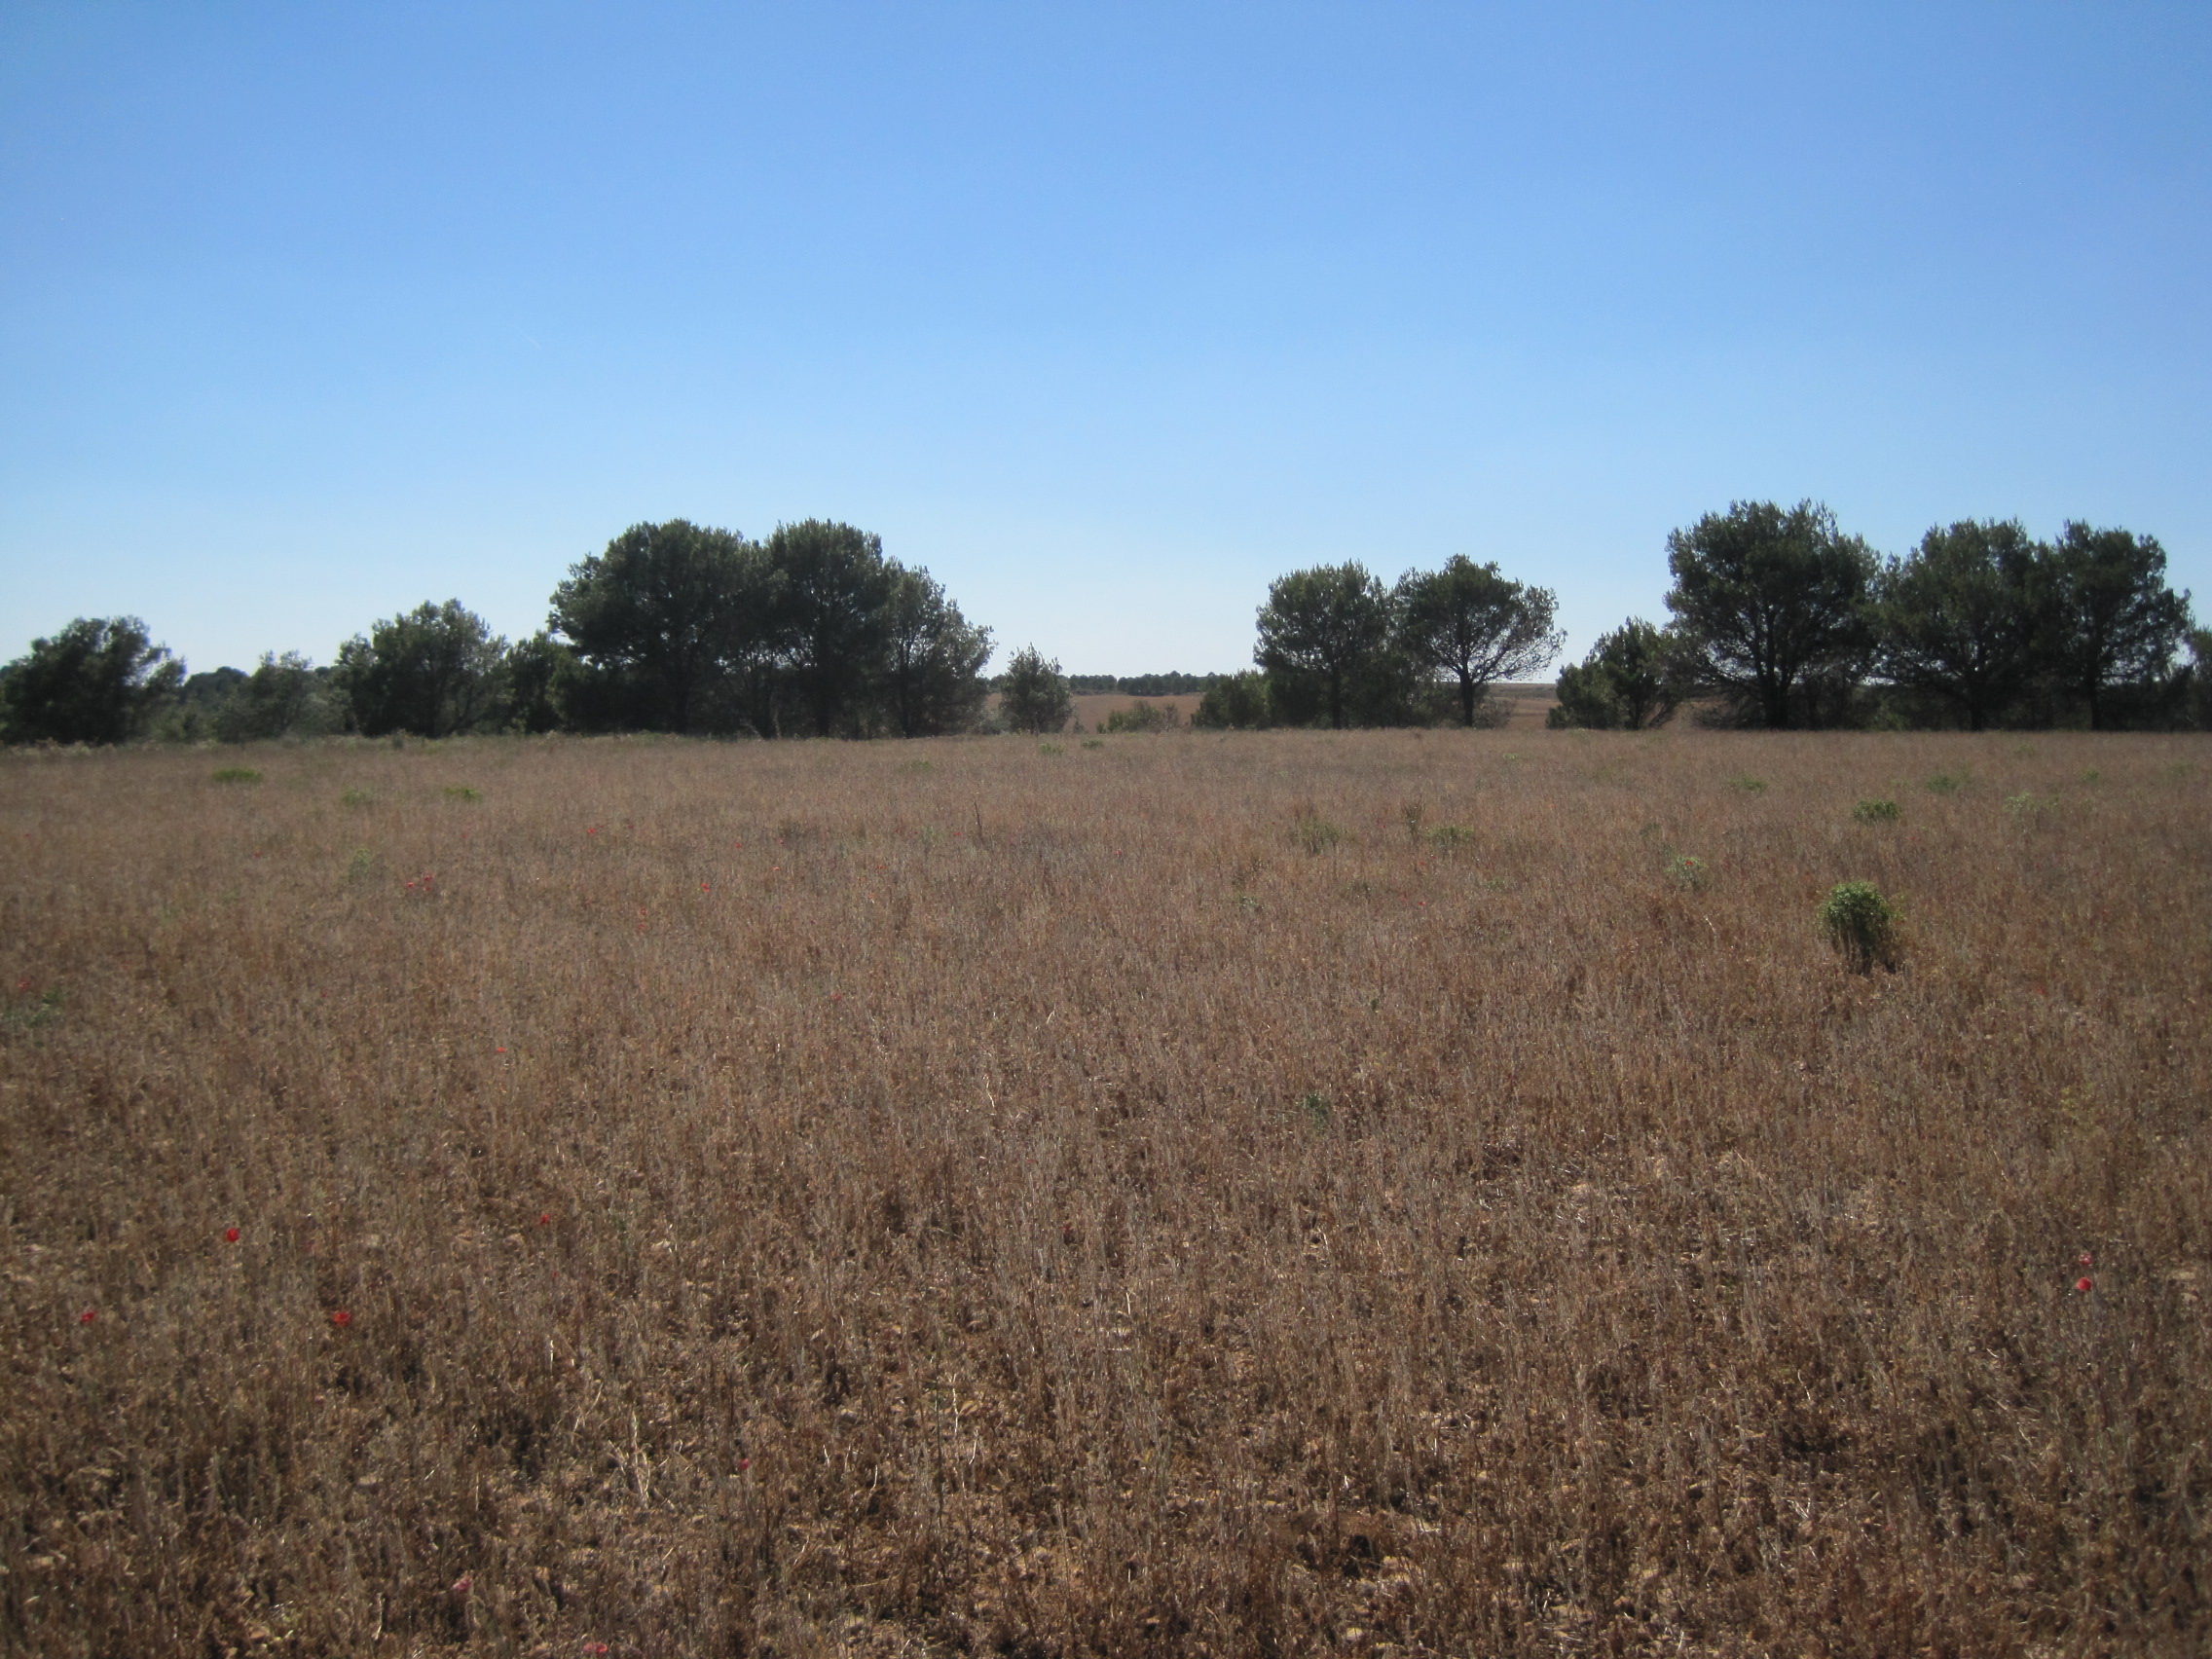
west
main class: Cropland
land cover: Dry pulses
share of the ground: > 75 %
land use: Agriculture (excluding fallow land and kitchen gardens)
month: June
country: ES
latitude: 41.6540
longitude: -5.1468
